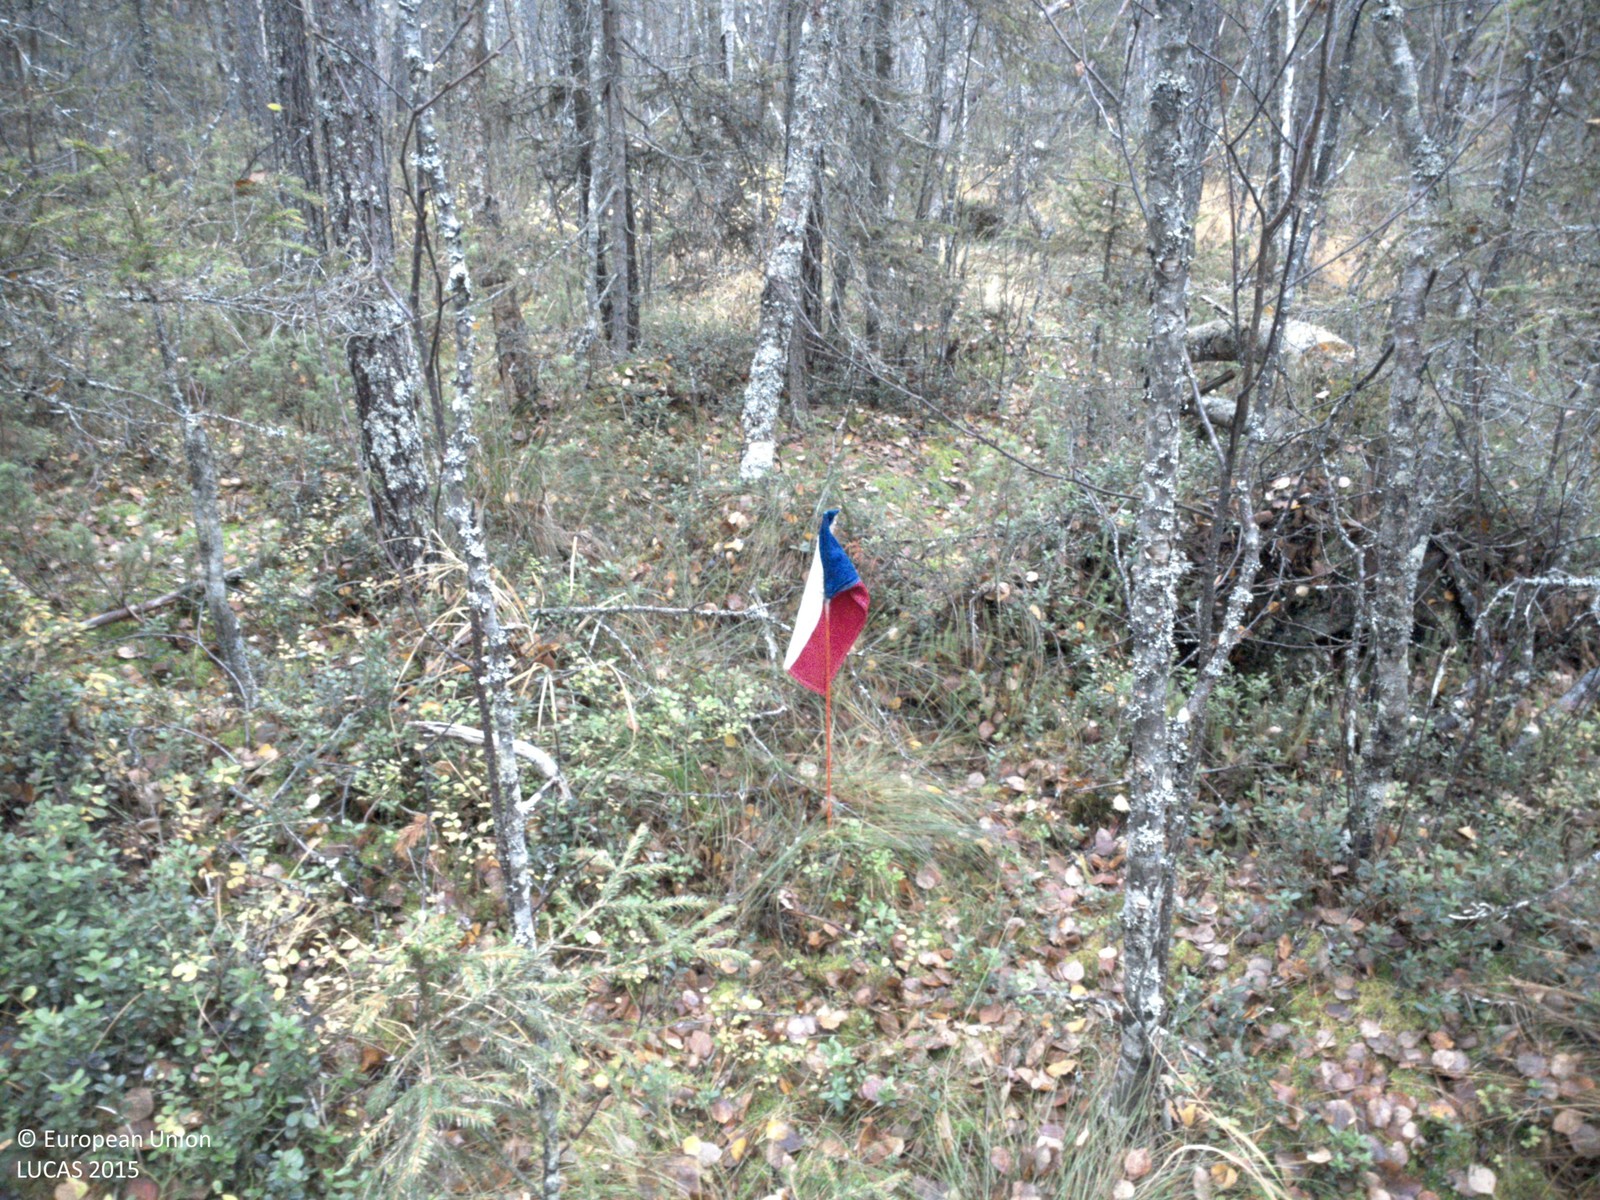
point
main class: Woodland
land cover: Pine dominated mixed woodland
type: boreal forest
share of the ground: > 75 %
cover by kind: coniferous forest trees 60 %, broadleaved forest trees 20 %, shrubs 10 %, herbaceous plants 5 %, lichens and mosses 5 %
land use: Forestry
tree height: > 5 m
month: September
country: SE
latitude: 64.8404
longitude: 18.8837
